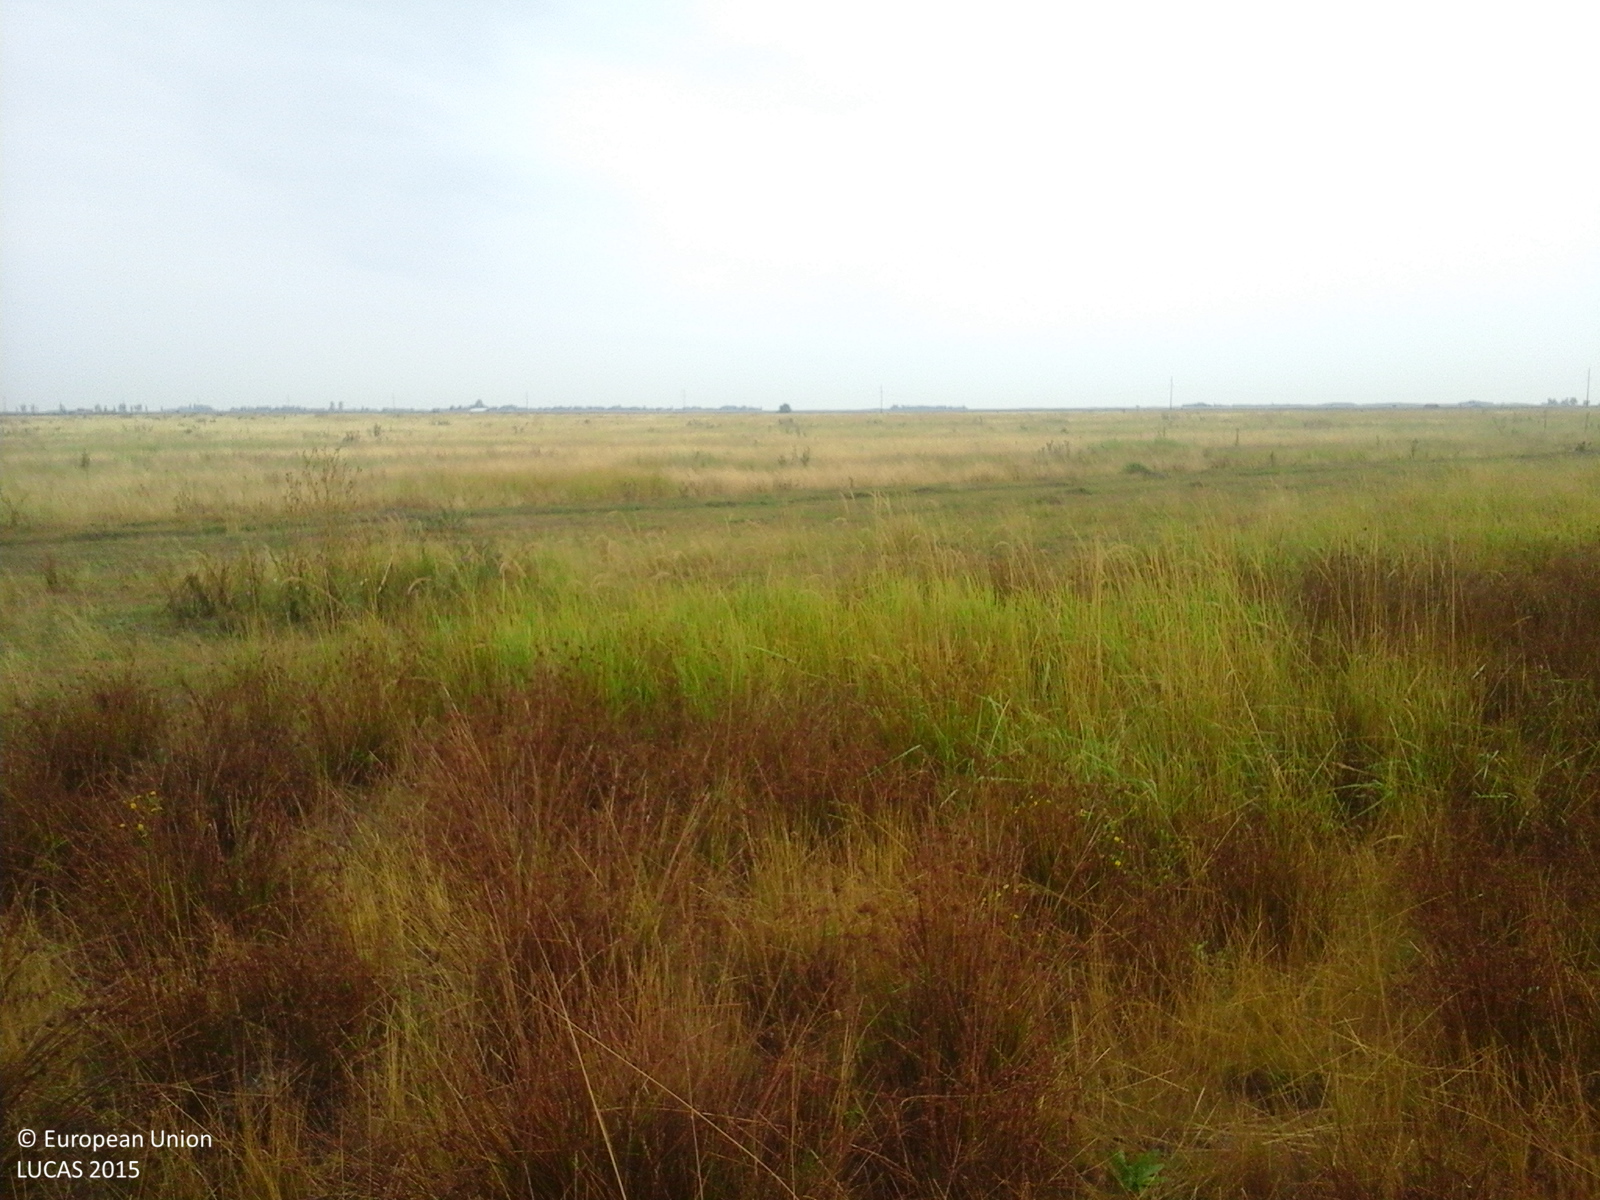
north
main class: Grassland
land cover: Spontaneously vegetated surfaces
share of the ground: > 75 %
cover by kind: herbaceous plants 100 %
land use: Fallow land
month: September
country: RO
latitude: 47.5737
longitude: 22.5679
